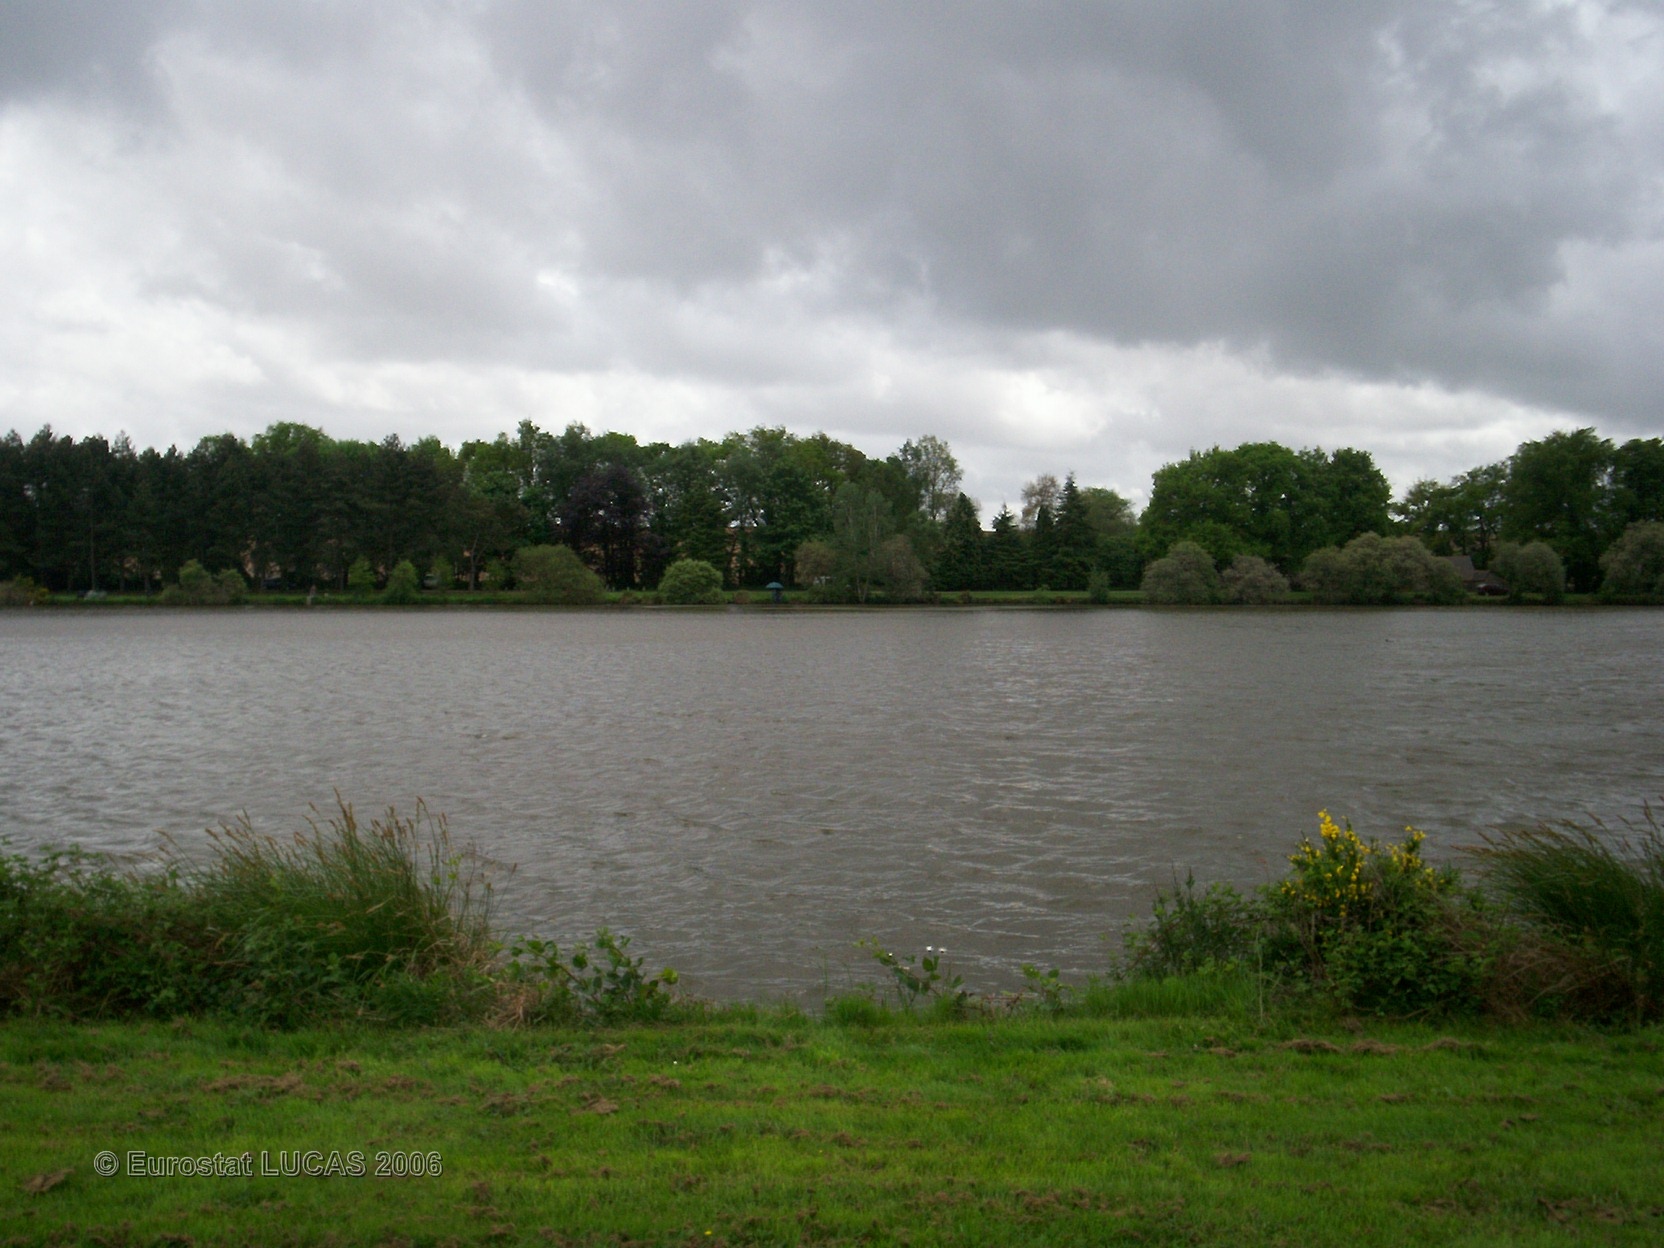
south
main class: Grassland
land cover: Grassland without tree/shrub cover
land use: Amenities, museums, leisure
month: May
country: FR
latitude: 47.9716
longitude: -2.7487
